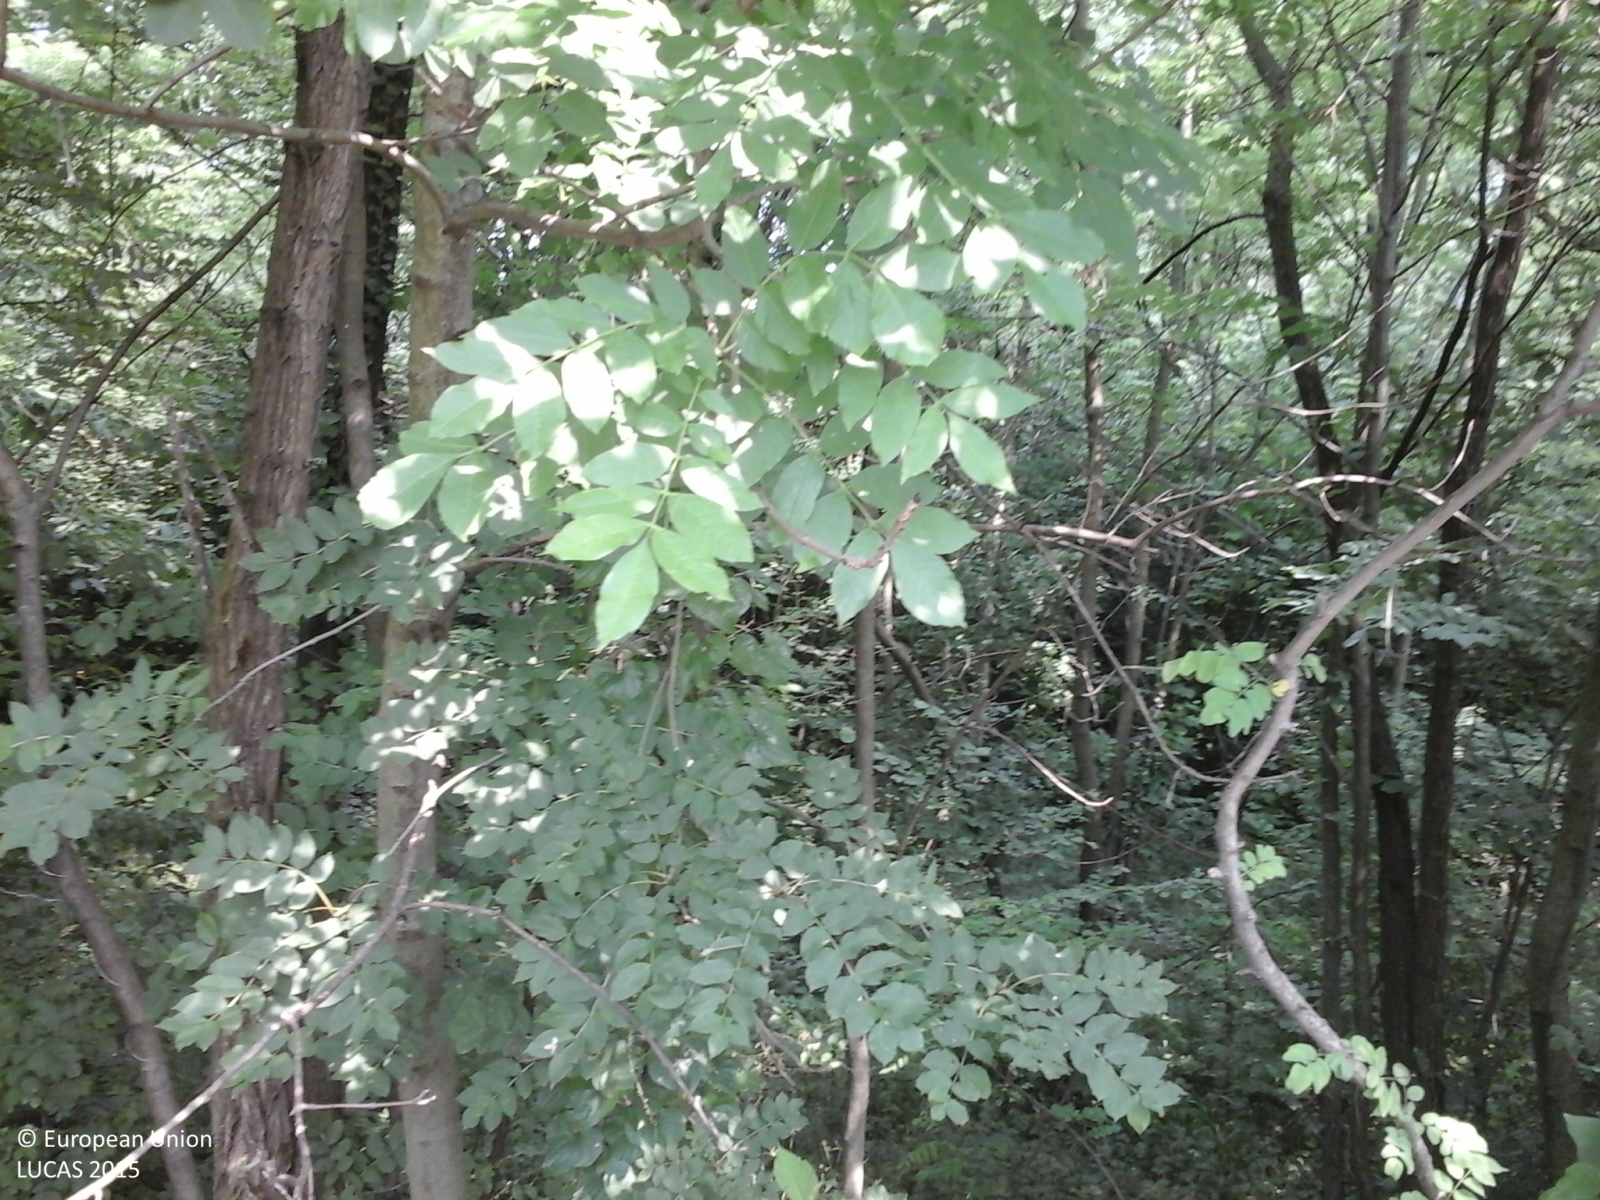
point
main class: Woodland
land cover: Broadleaved woodland
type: thermophilous deciduous forest
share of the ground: > 75 %
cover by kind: broadleaved forest trees 100 %
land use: Semi-natural and natural areas not in use
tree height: > 5 m
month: May
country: IT
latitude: 45.3896
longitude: 7.7173
